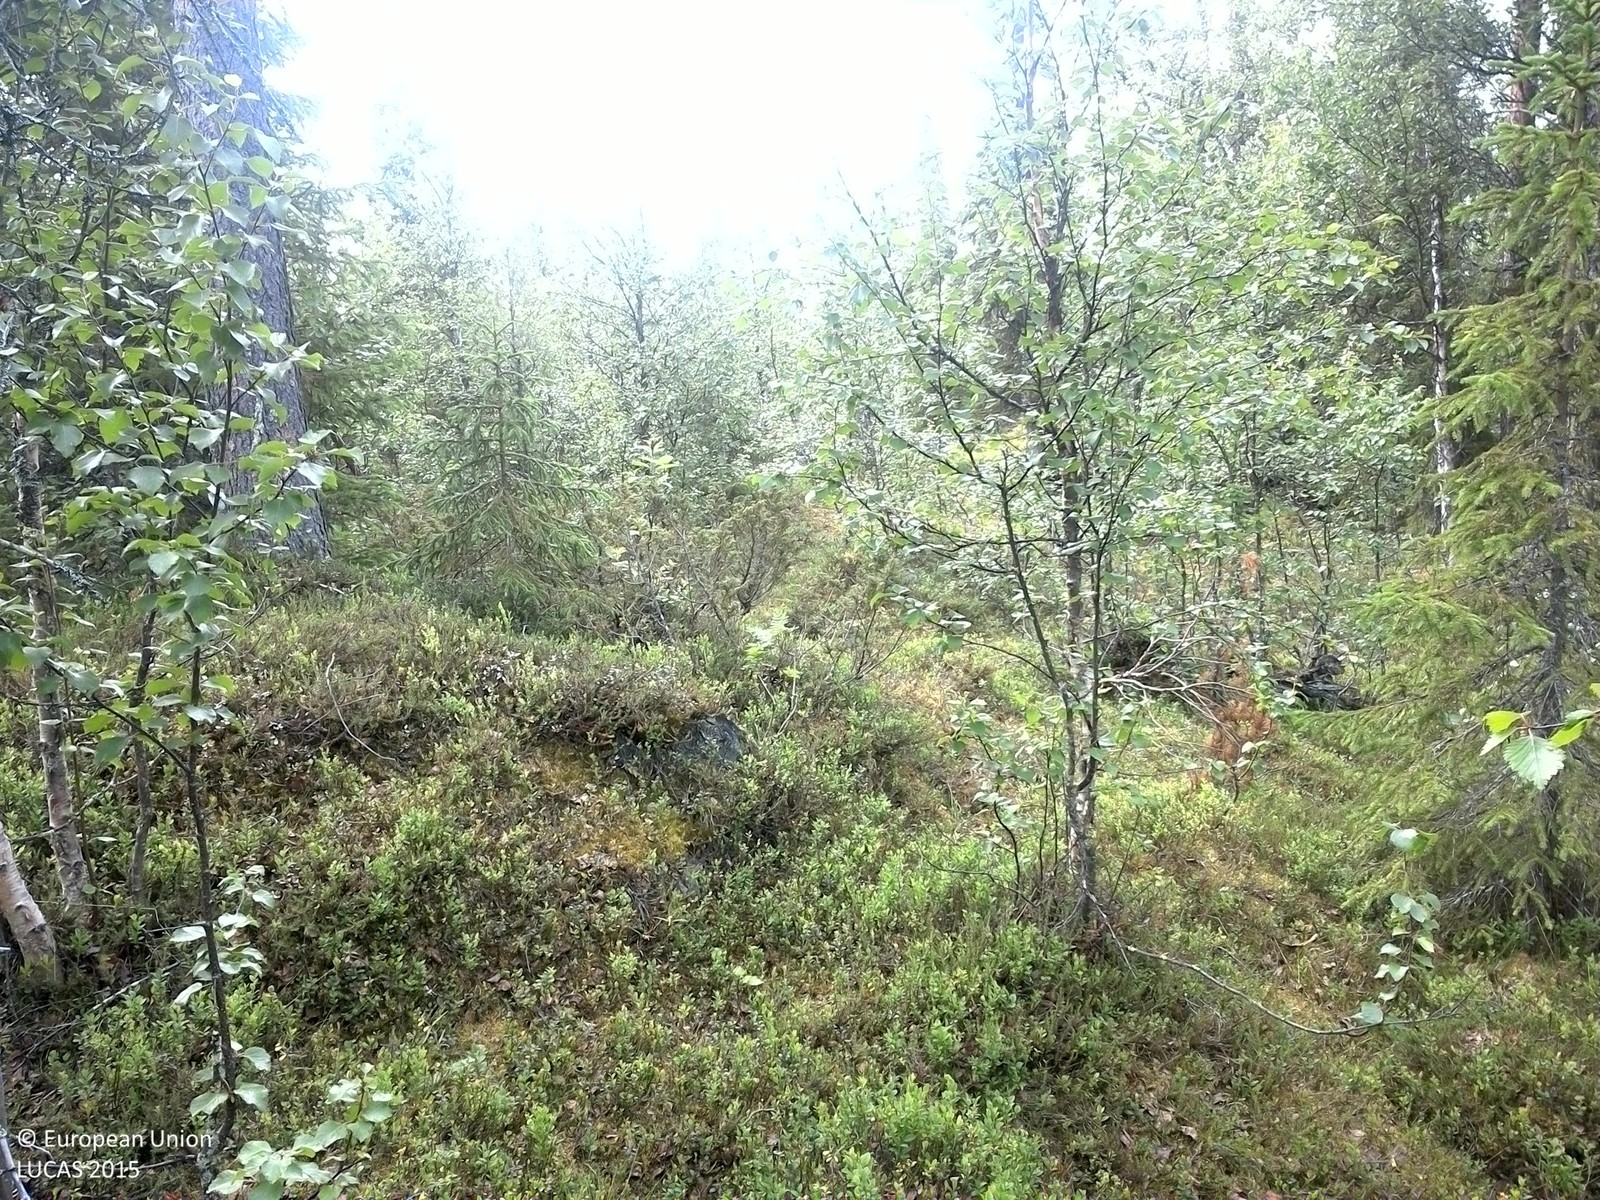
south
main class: Woodland
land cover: Other mixed woodland
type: boreal forest
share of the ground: 50 - 75 %
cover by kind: coniferous forest trees 30 %, shrubs 30 %, broadleaved forest trees 25 %, lichens and mosses 15 %
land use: Forestry
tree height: > 5 m
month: July
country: SE
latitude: 64.7168
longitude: 15.5717
